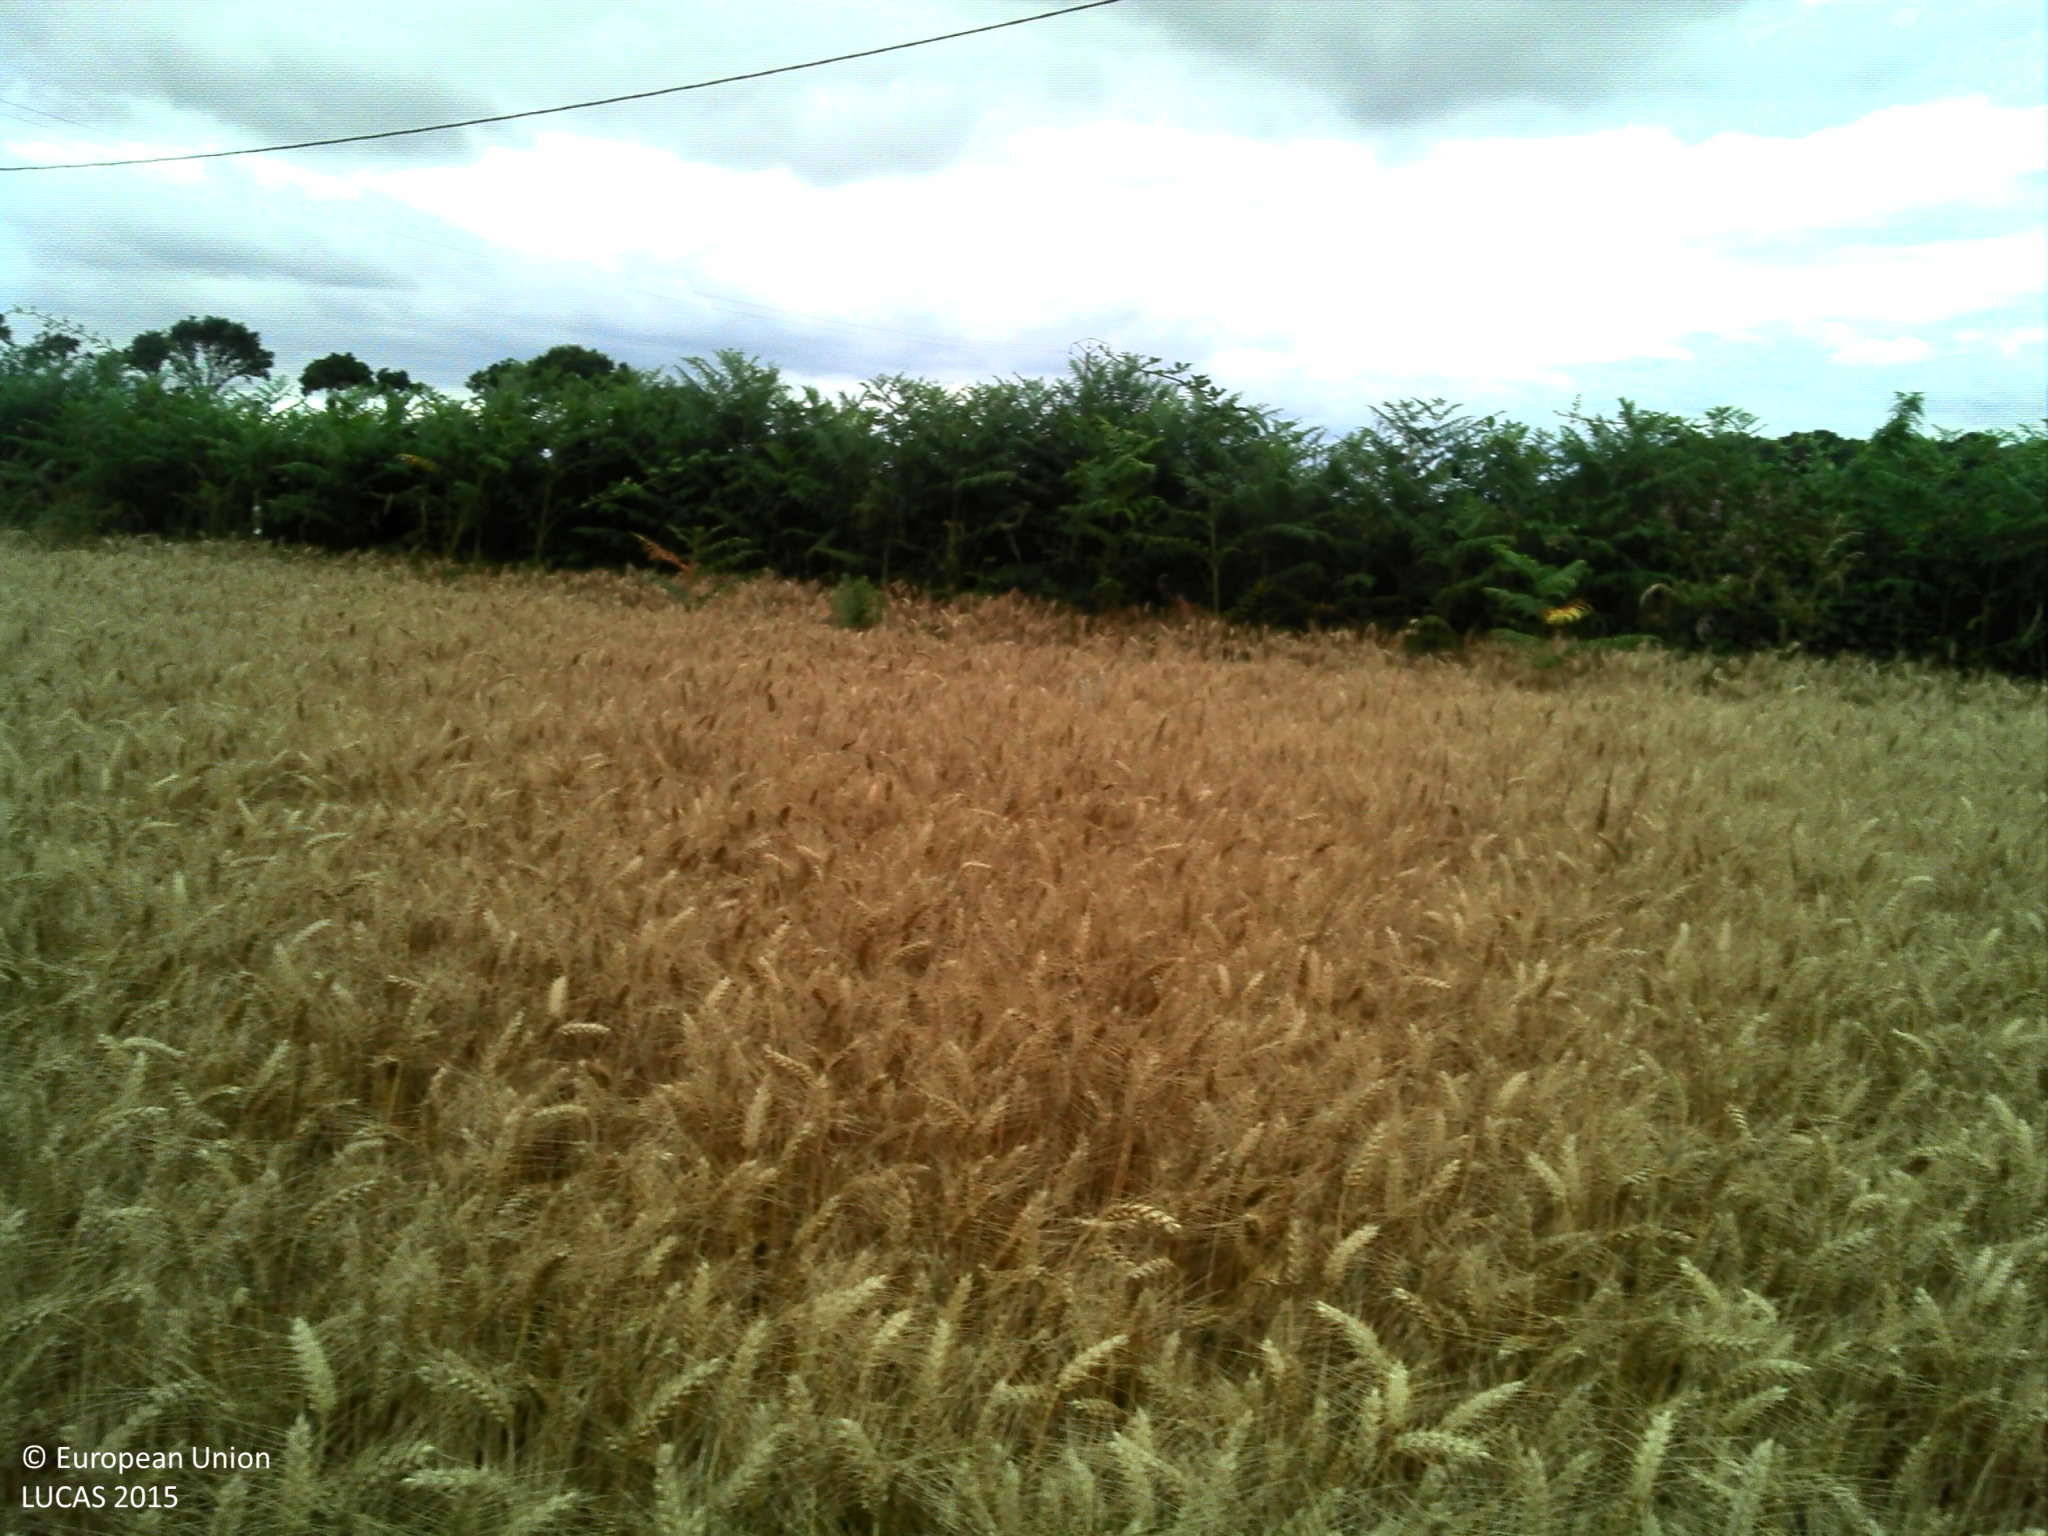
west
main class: Cropland
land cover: Durum wheat
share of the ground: > 75 %
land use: Agriculture (excluding fallow land and kitchen gardens)
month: July
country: FR
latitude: 47.7959
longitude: -2.0536
